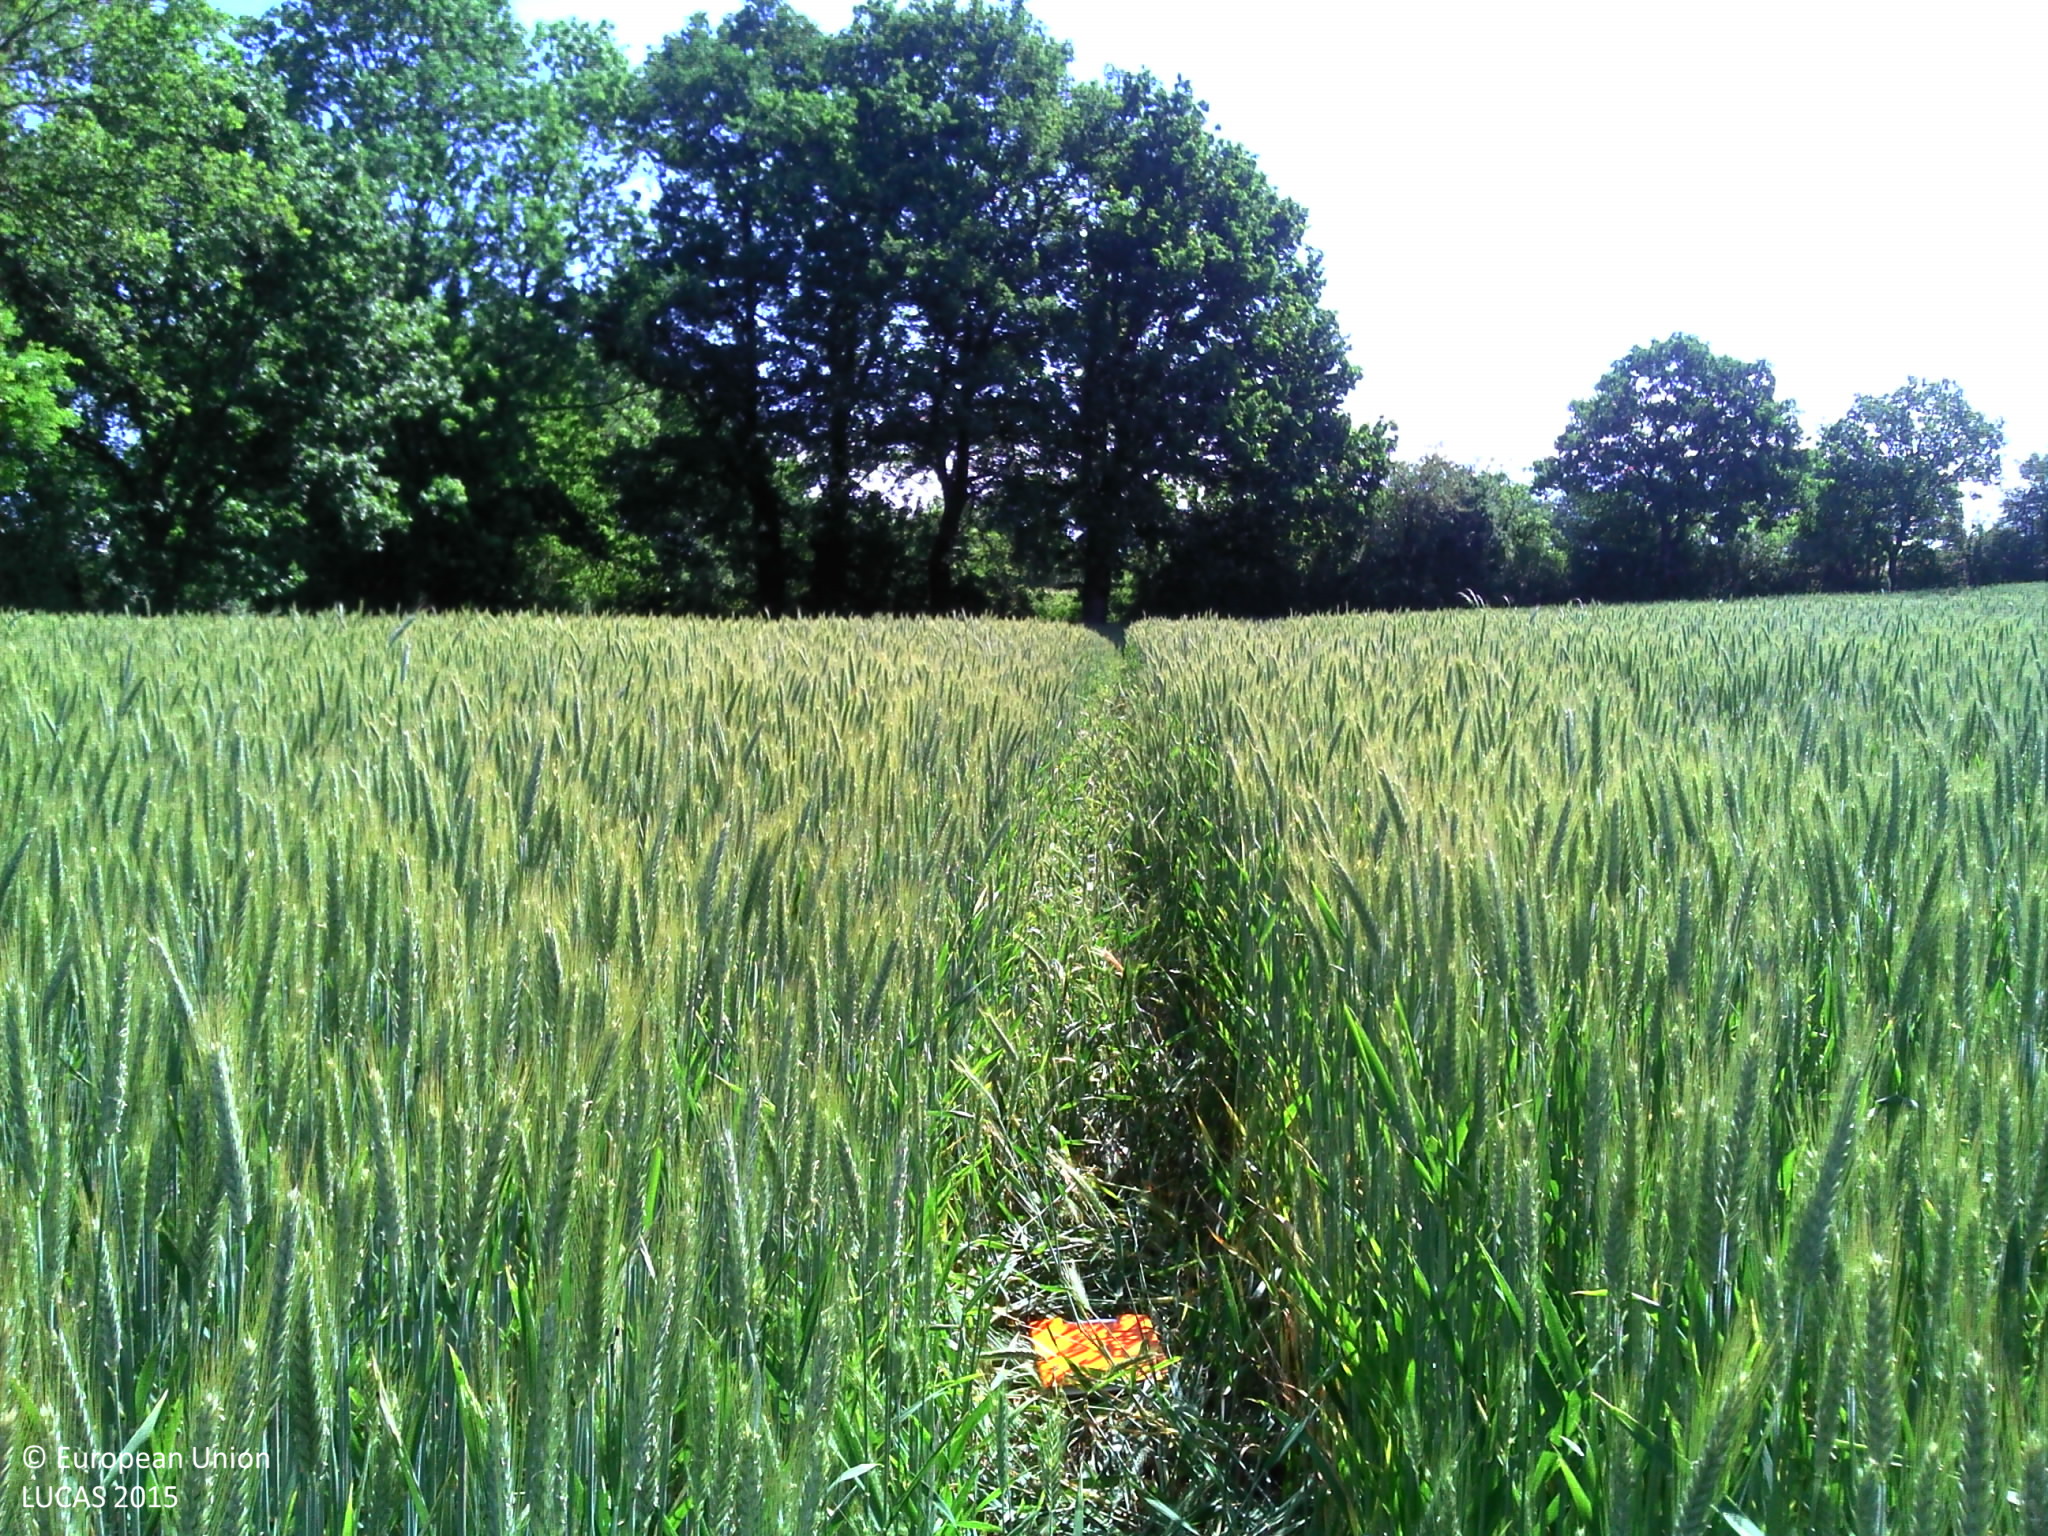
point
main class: Cropland
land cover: Rye
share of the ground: > 75 %
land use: Agriculture (excluding fallow land and kitchen gardens)
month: May
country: FR
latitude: 46.2691
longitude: 2.7696
